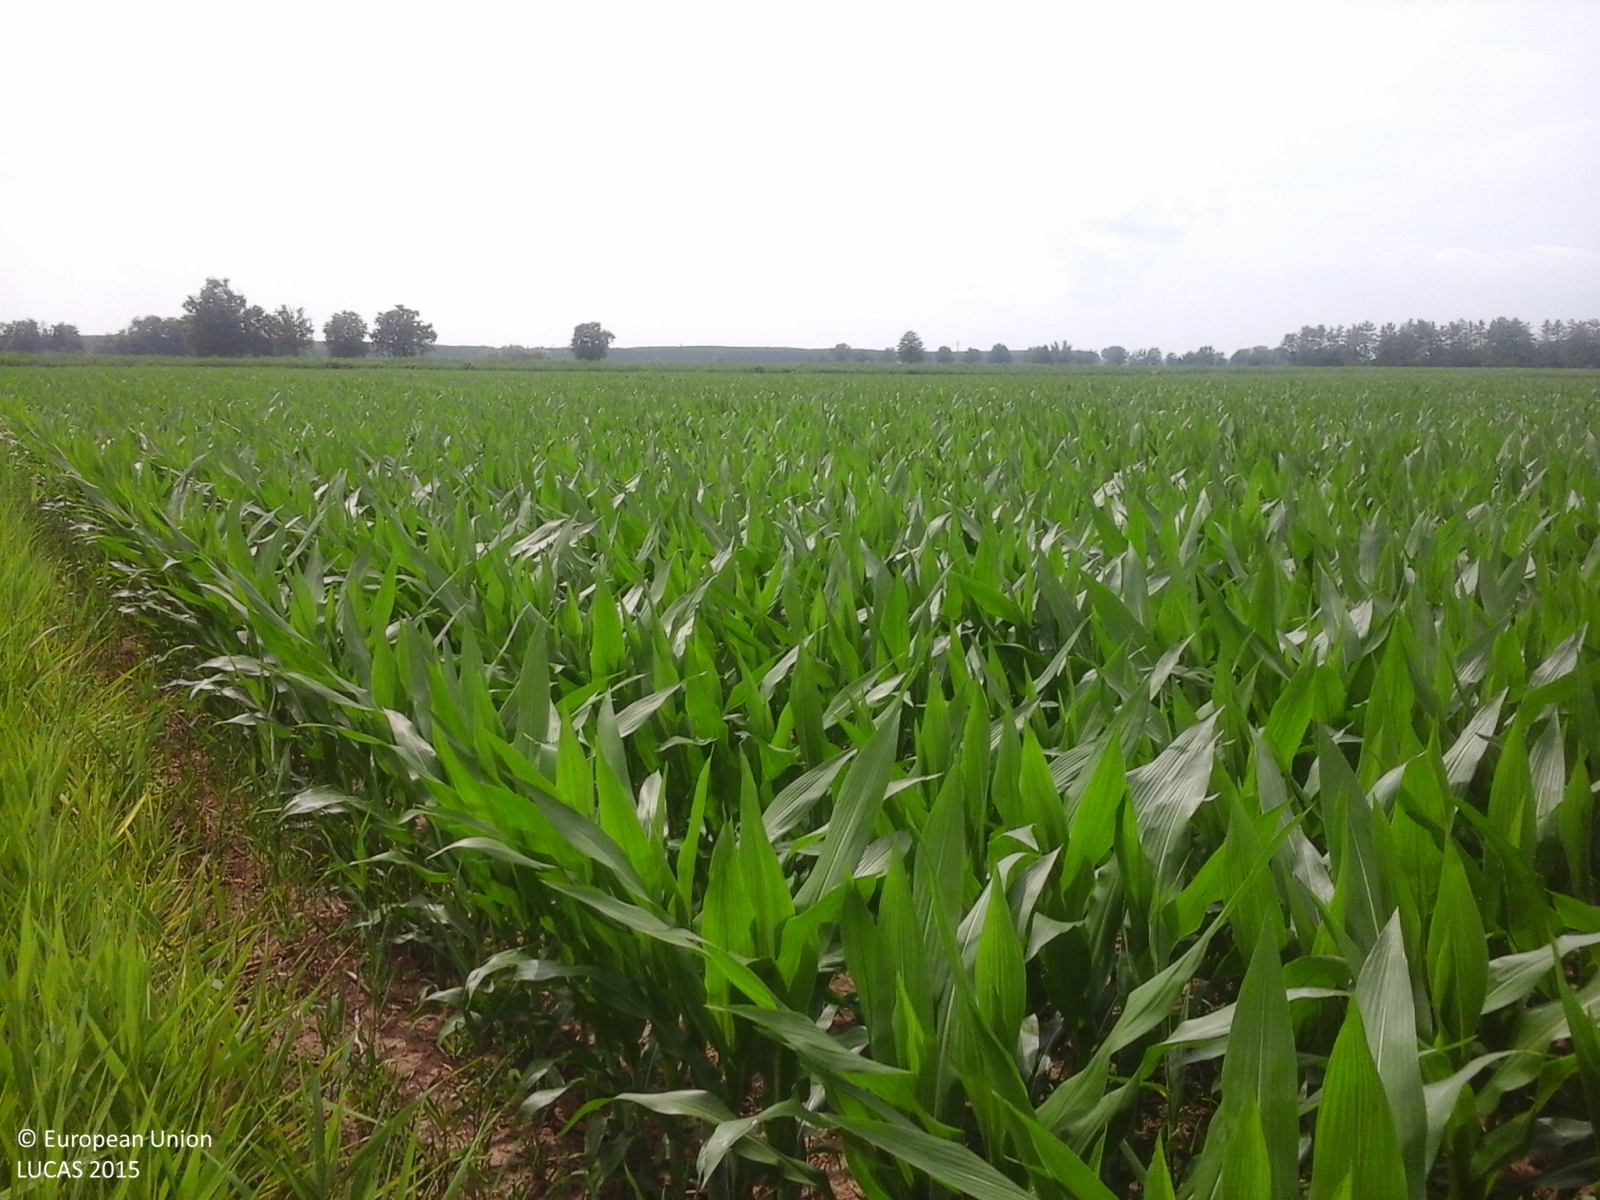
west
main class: Cropland
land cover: Maize
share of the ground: > 75 %
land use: Agriculture (excluding fallow land and kitchen gardens)
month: June
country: IT
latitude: 45.0640
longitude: 8.7197
